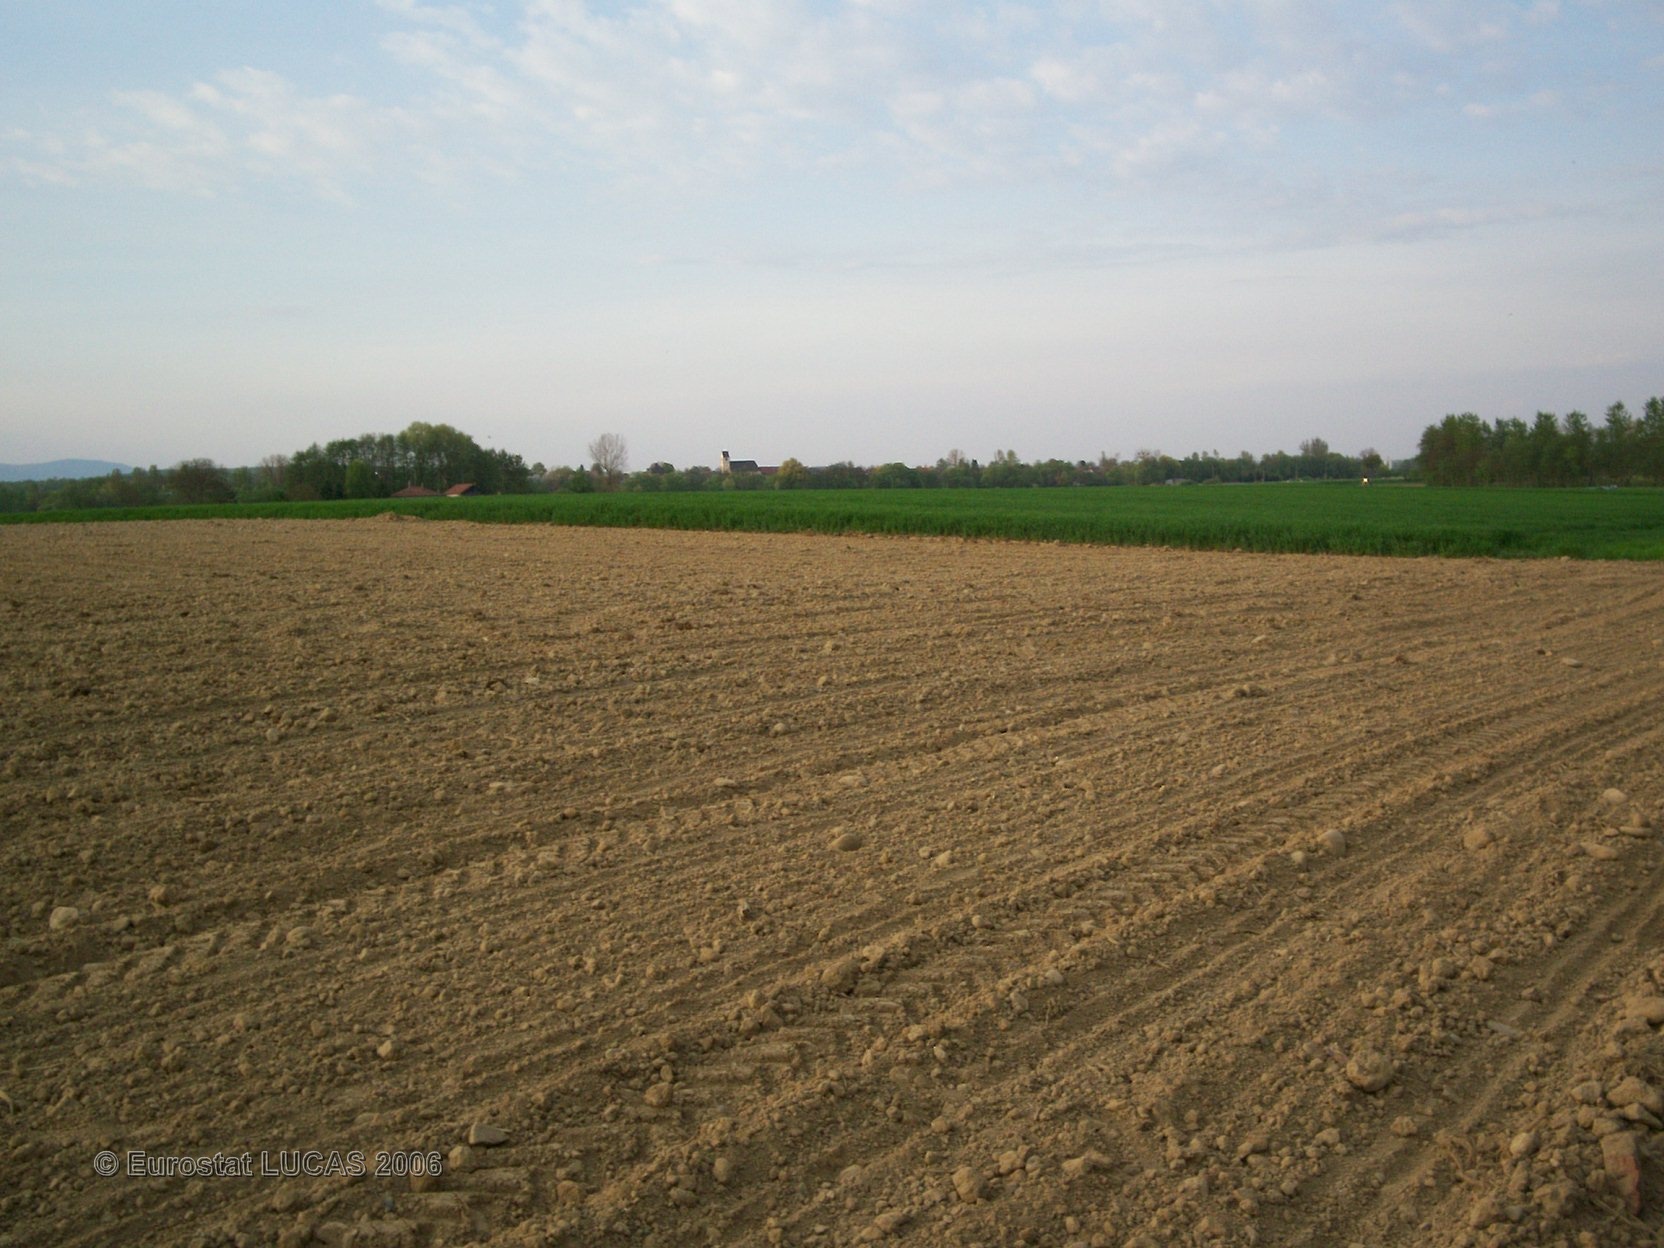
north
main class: Cropland
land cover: Maize
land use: Agriculture (excluding fallow land and kitchen gardens)
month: May
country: FR
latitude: 47.6462
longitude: 7.1395
